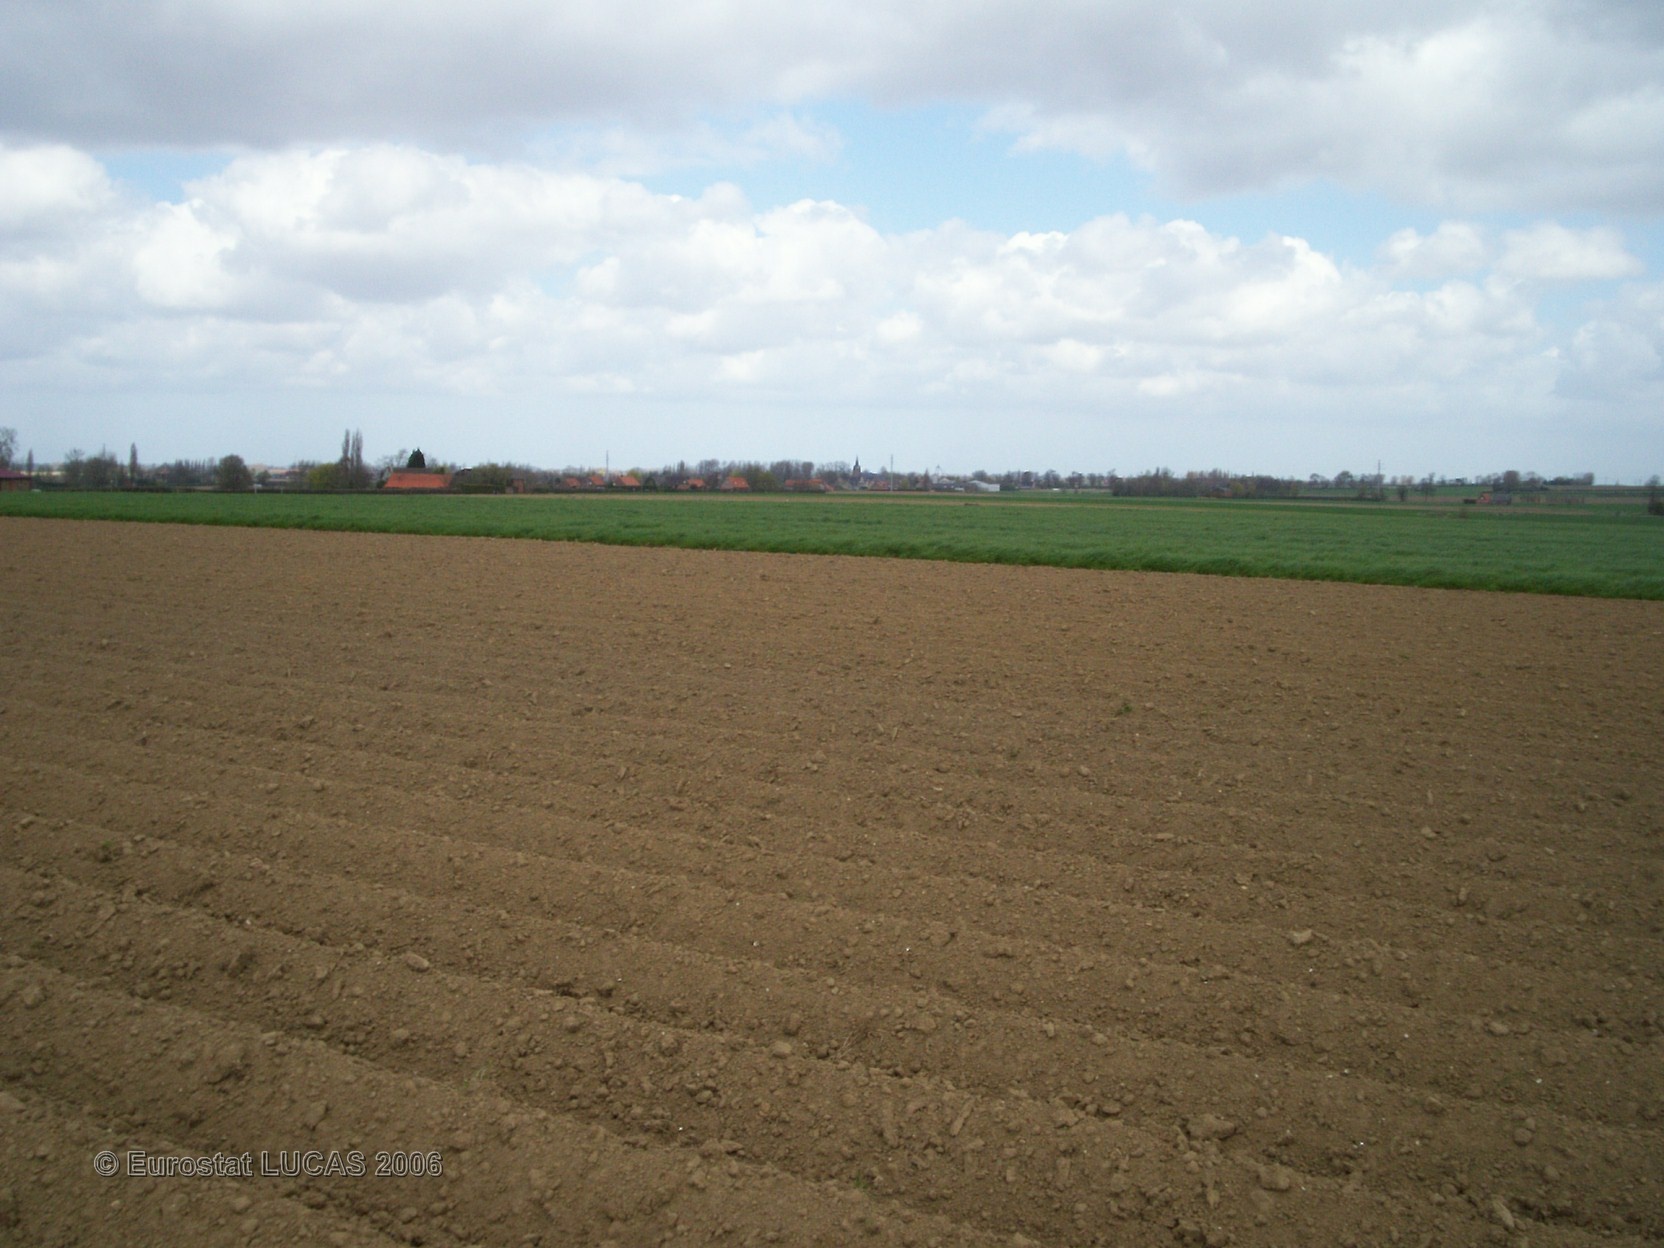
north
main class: Cropland
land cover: Potatoes
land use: Agriculture (excluding fallow land and kitchen gardens)
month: April
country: FR
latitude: 50.8224
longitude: 2.5063
